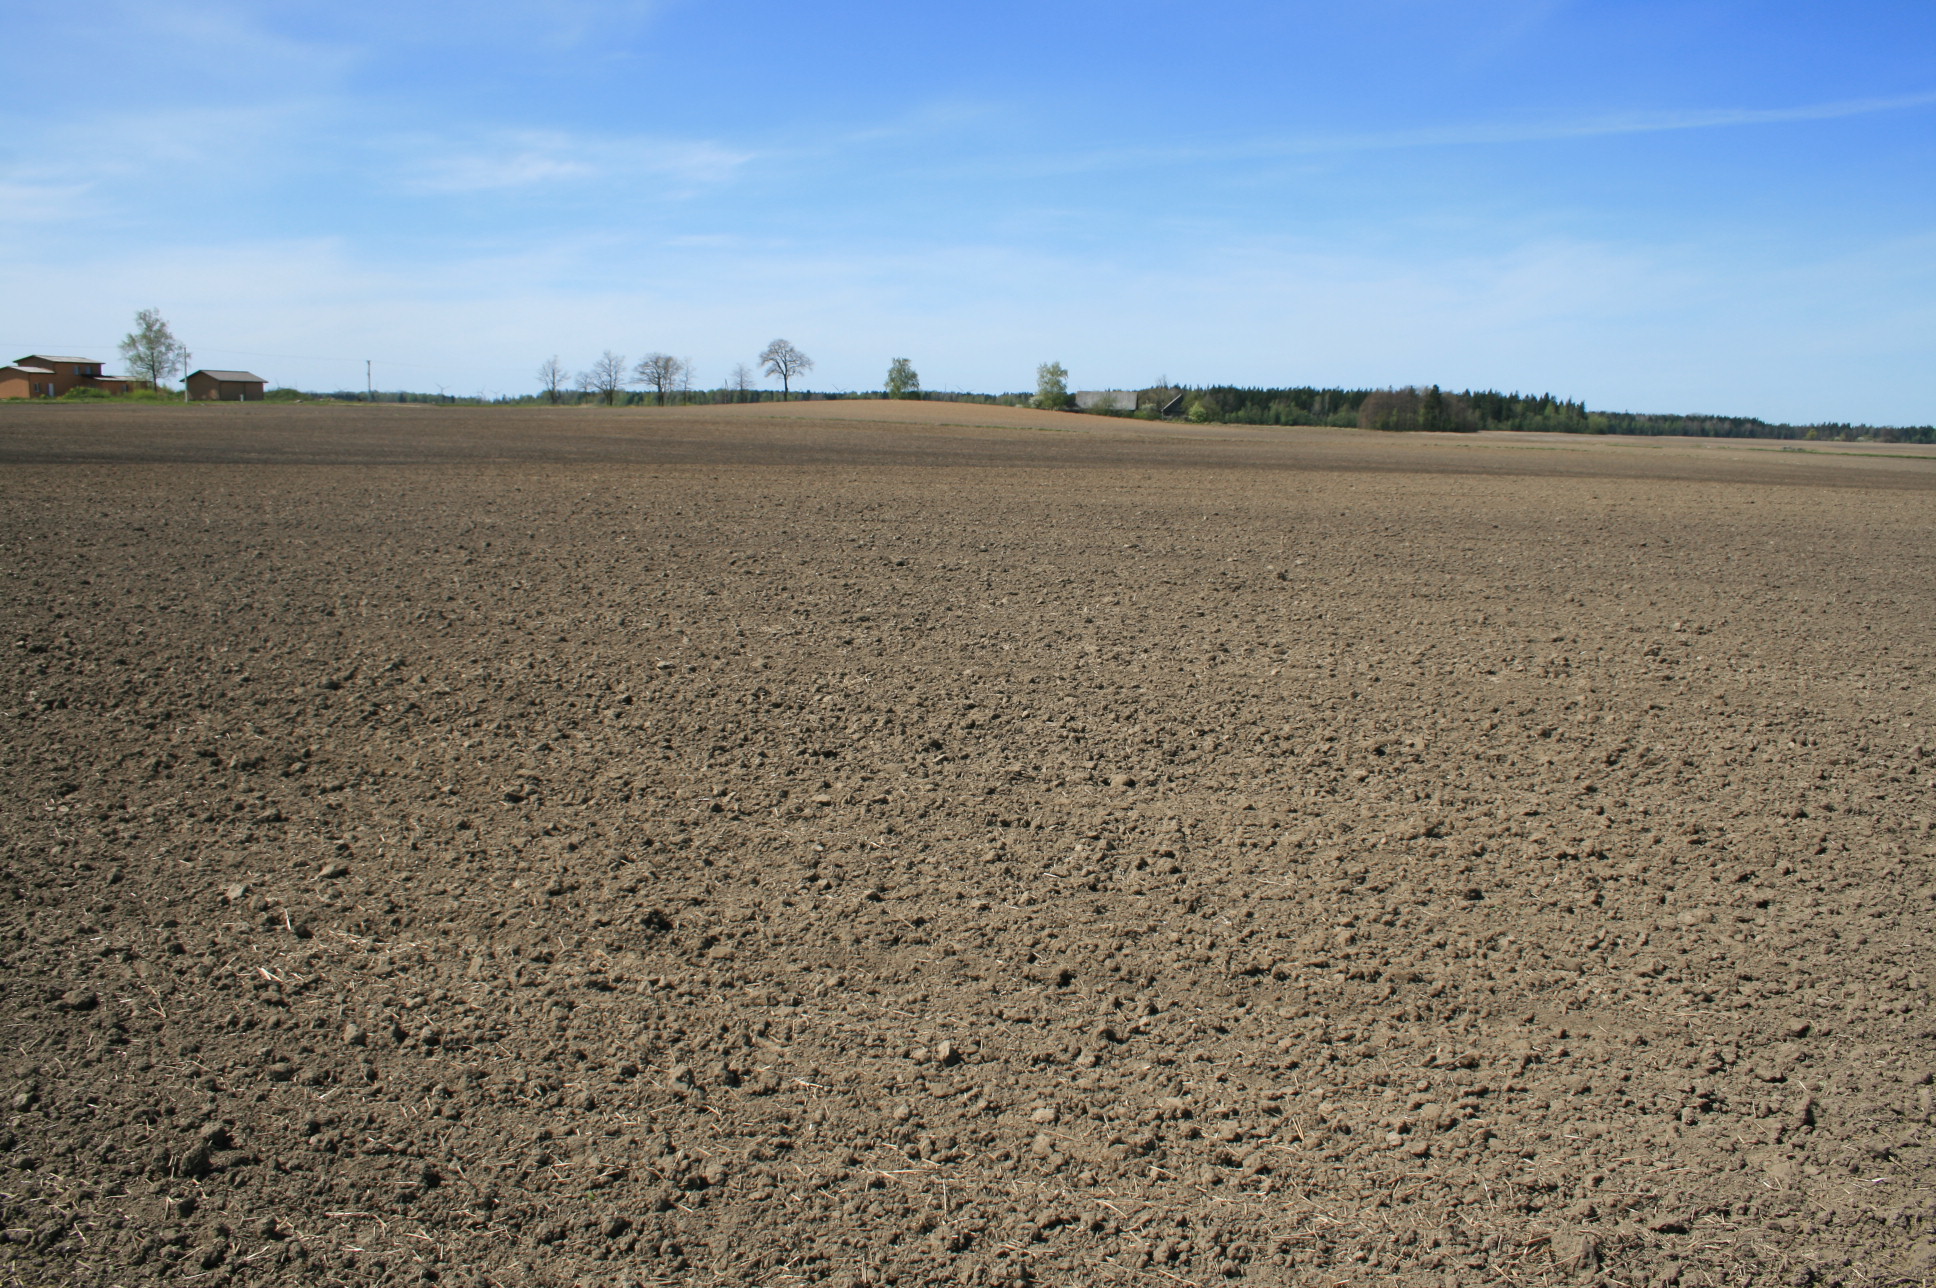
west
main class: Cropland
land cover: Barley
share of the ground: < 10 %
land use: Agriculture (excluding fallow land and kitchen gardens)
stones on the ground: < 10 %
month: May
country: LT
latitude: 56.0804
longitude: 21.3701
